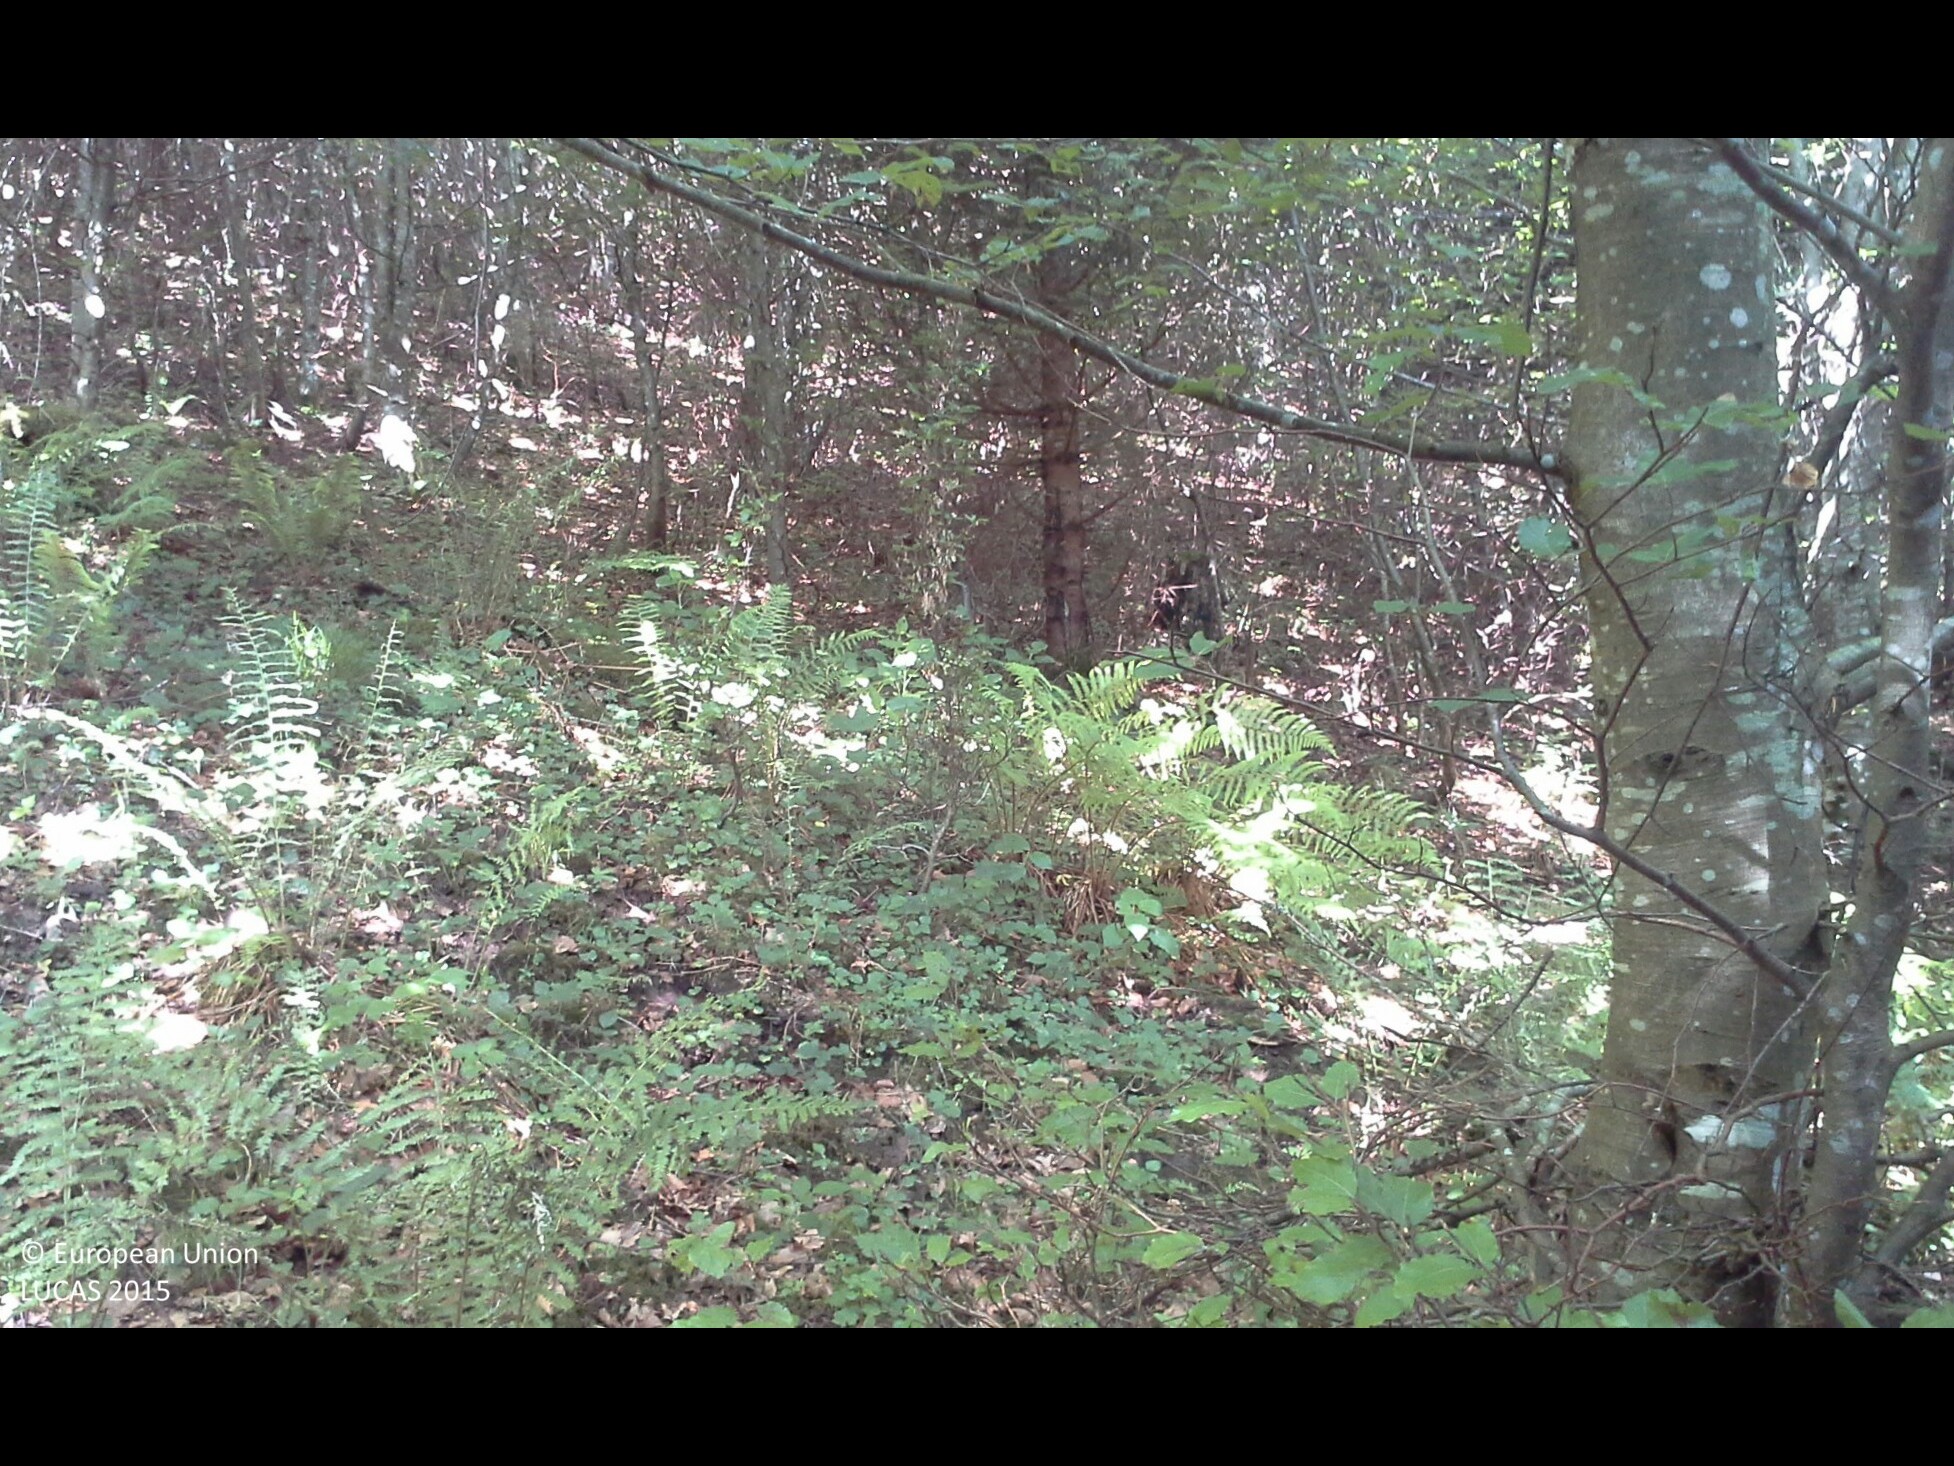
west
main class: Woodland
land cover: Spruce dominated mixed woodland
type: mountainous beech forest
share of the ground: > 75 %
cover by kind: coniferous forest trees 55 %, broadleaved forest trees 35 %, herbaceous plants 10 %
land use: Forestry
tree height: > 5 m
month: June
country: AT
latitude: 47.8443
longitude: 14.4762
